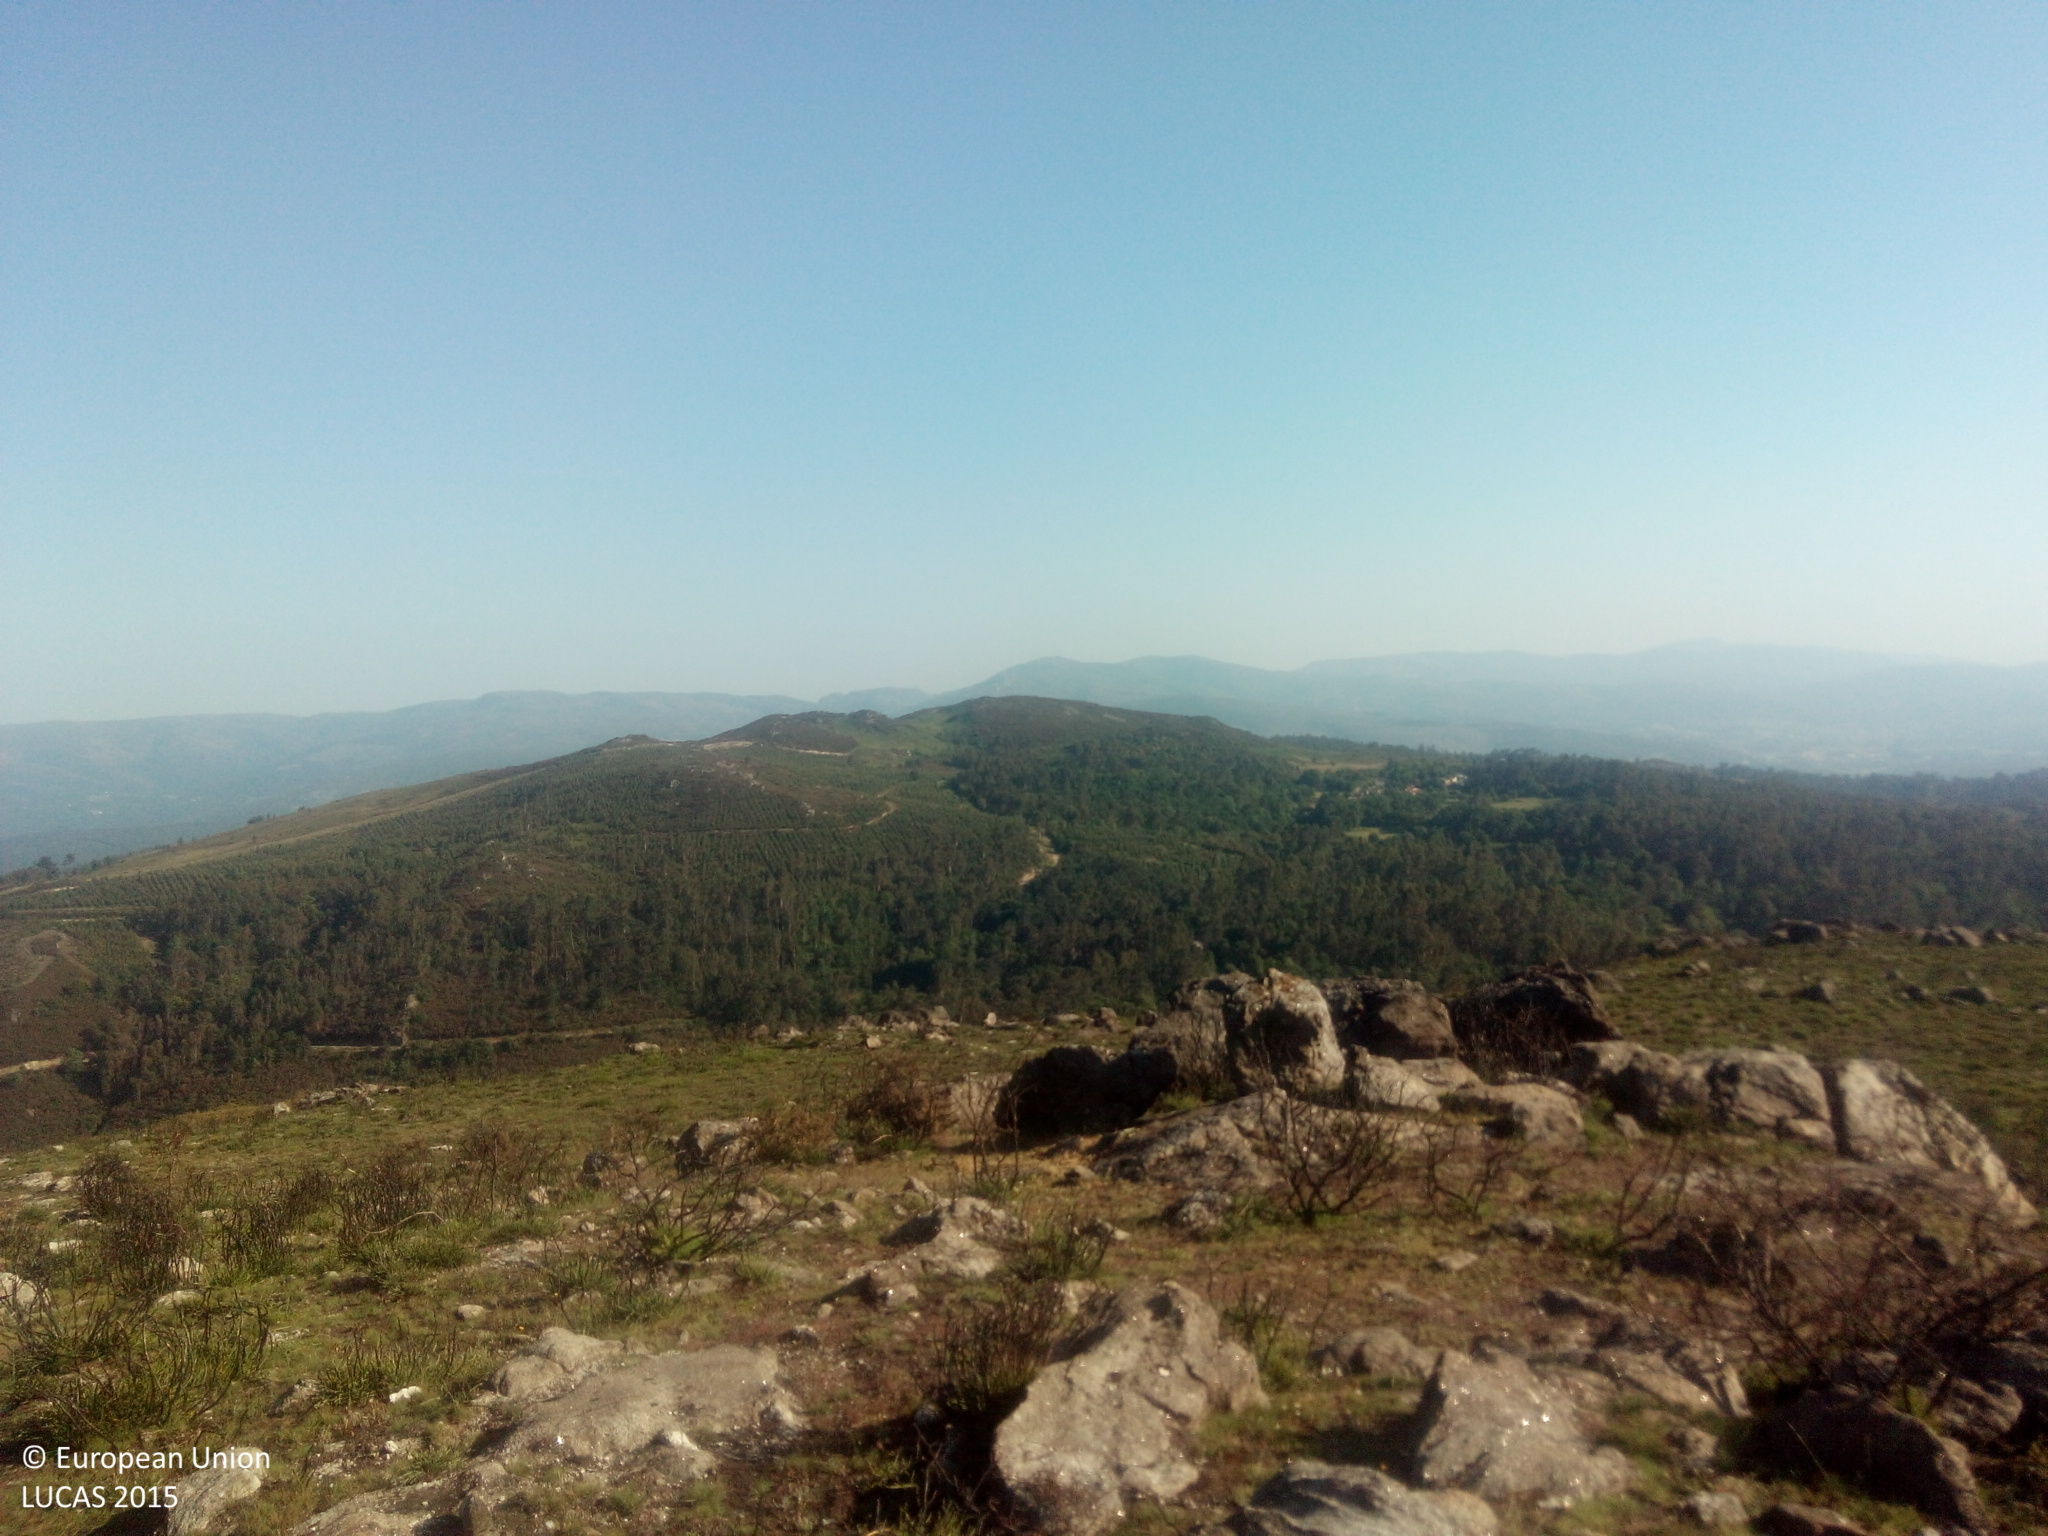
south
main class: Shrubland
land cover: Shrubland without tree cover
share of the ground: > 75 %
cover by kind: shrubs 100 %
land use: Semi-natural and natural areas not in use
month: June
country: ES
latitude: 42.2043
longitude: -8.2165
